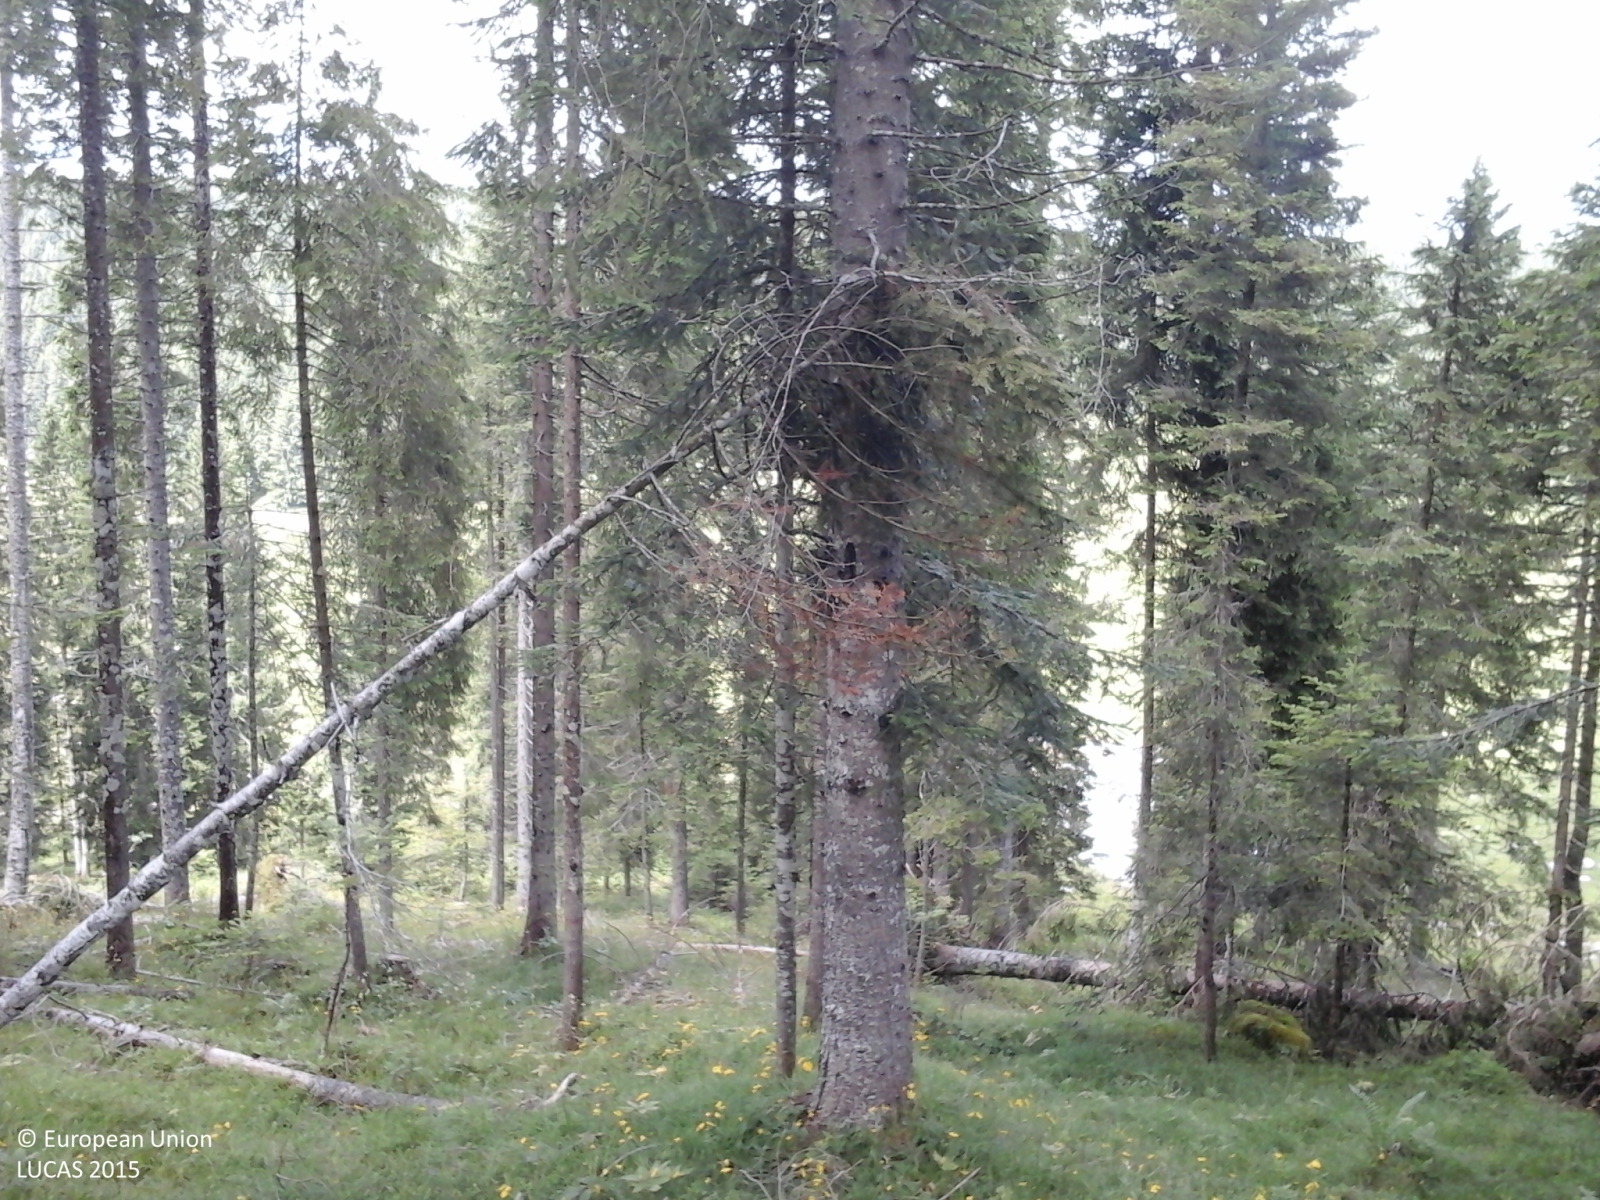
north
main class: Woodland
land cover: Spruce dominated coniferous woodland
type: alpine coniferous forest
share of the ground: > 75 %
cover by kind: coniferous forest trees 100 %
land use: Forestry
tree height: > 5 m
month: June
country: IT
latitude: 45.9431
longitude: 11.5843
